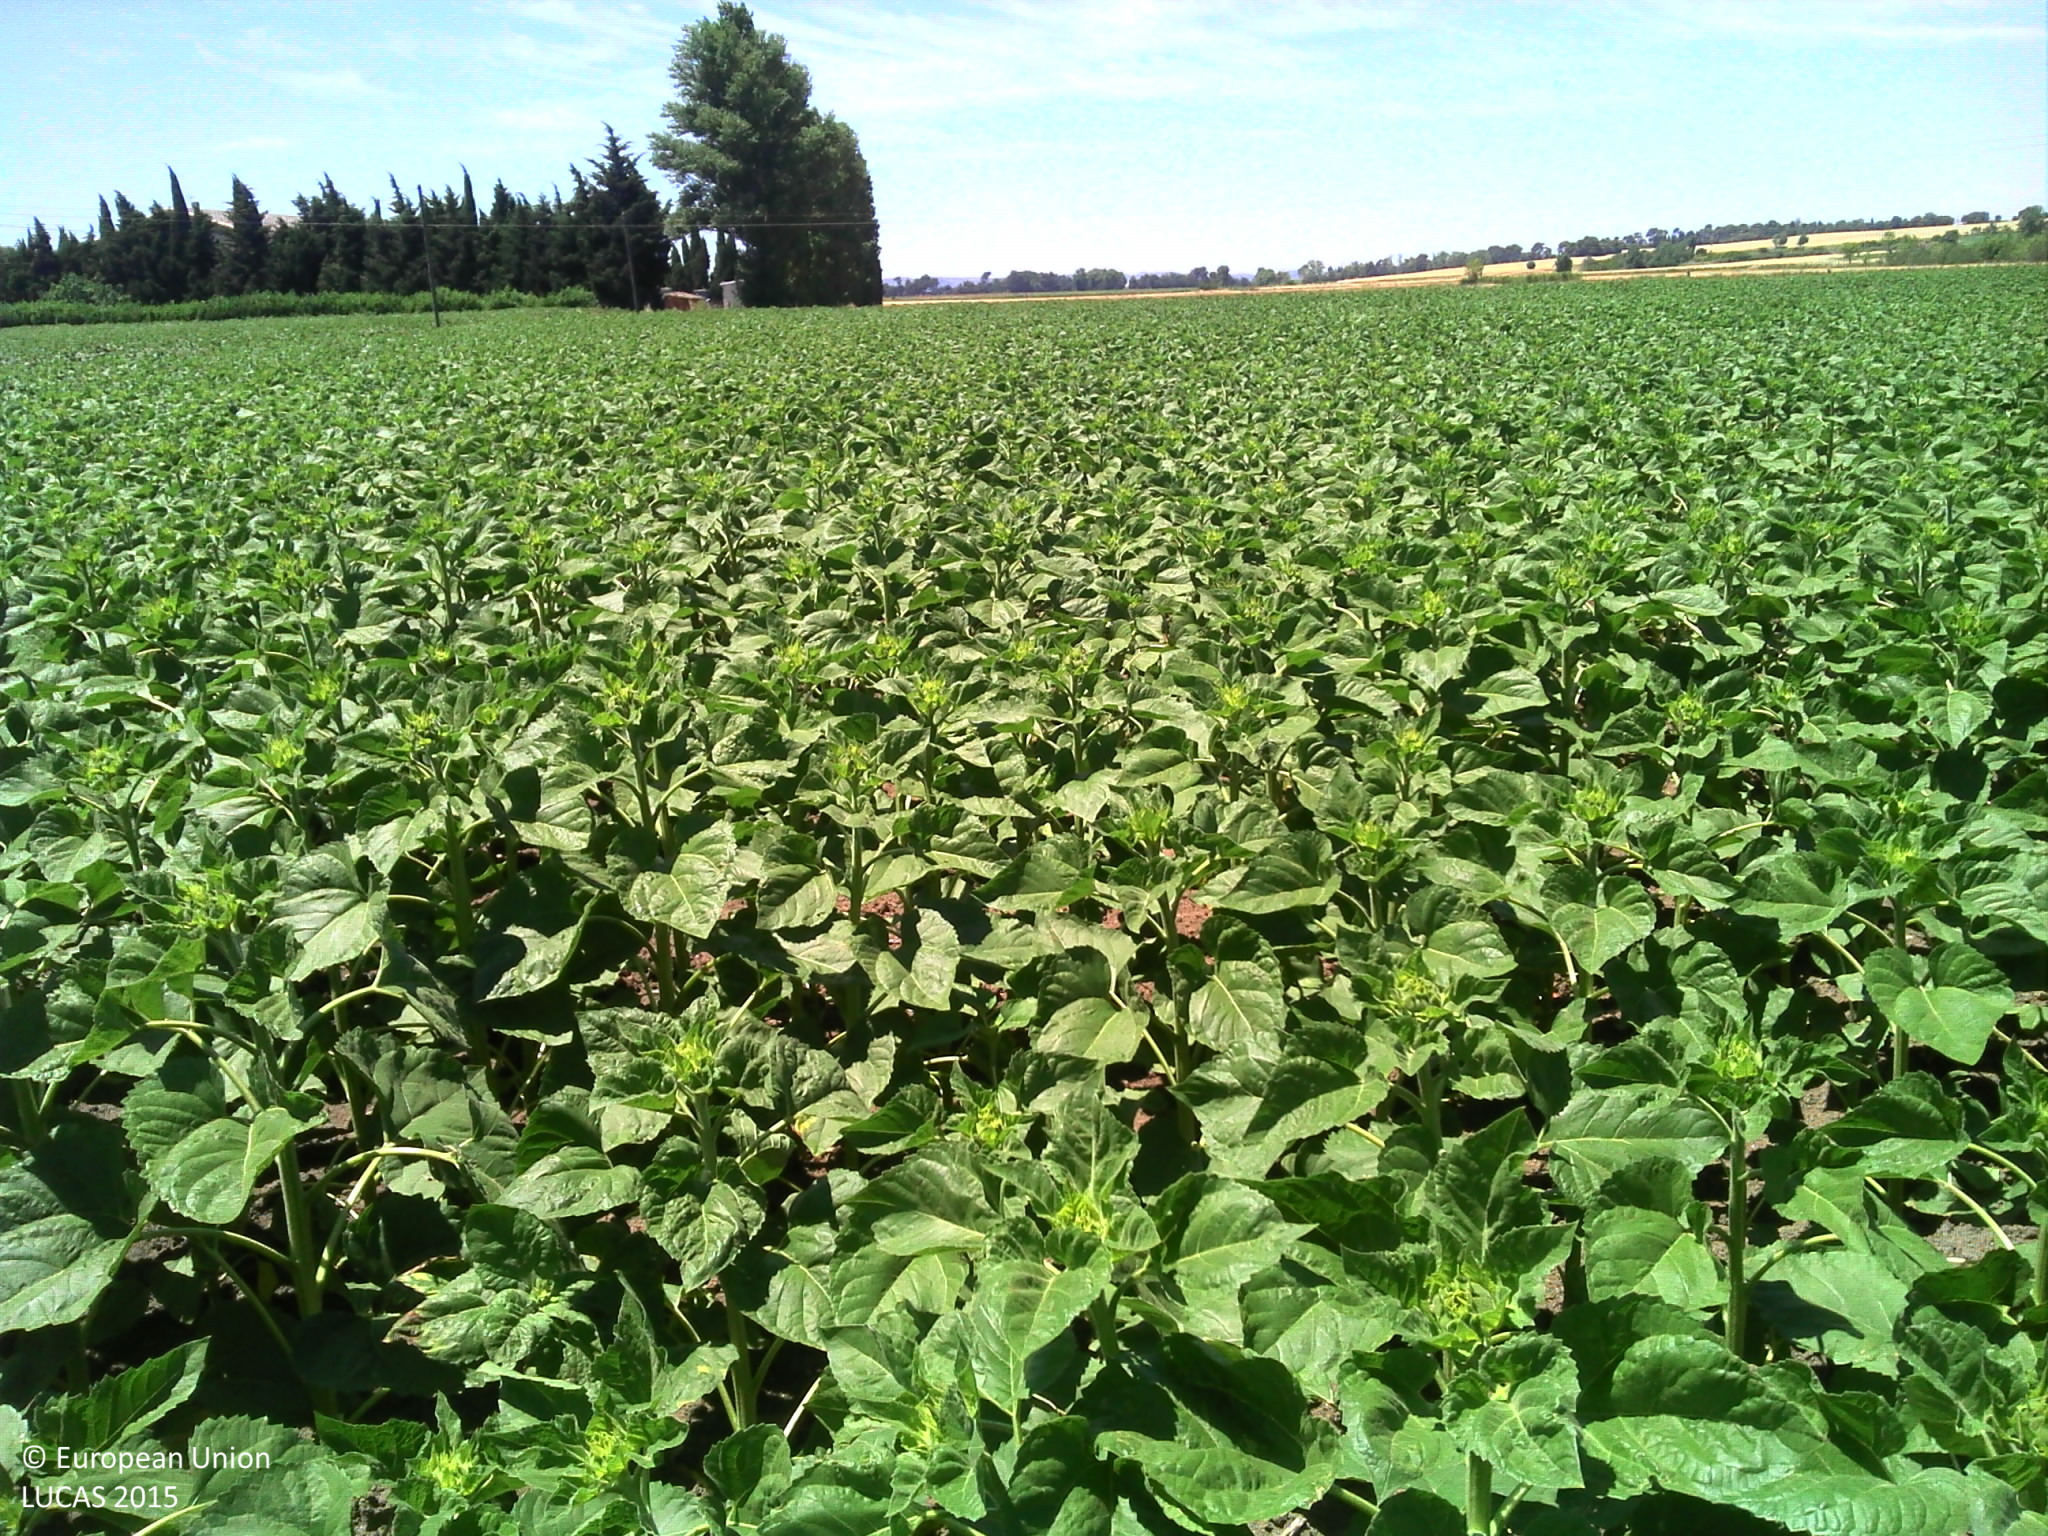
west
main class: Cropland
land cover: Sunflower
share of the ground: > 75 %
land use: Agriculture (excluding fallow land and kitchen gardens)
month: June
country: FR
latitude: 43.2526
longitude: 2.1117
